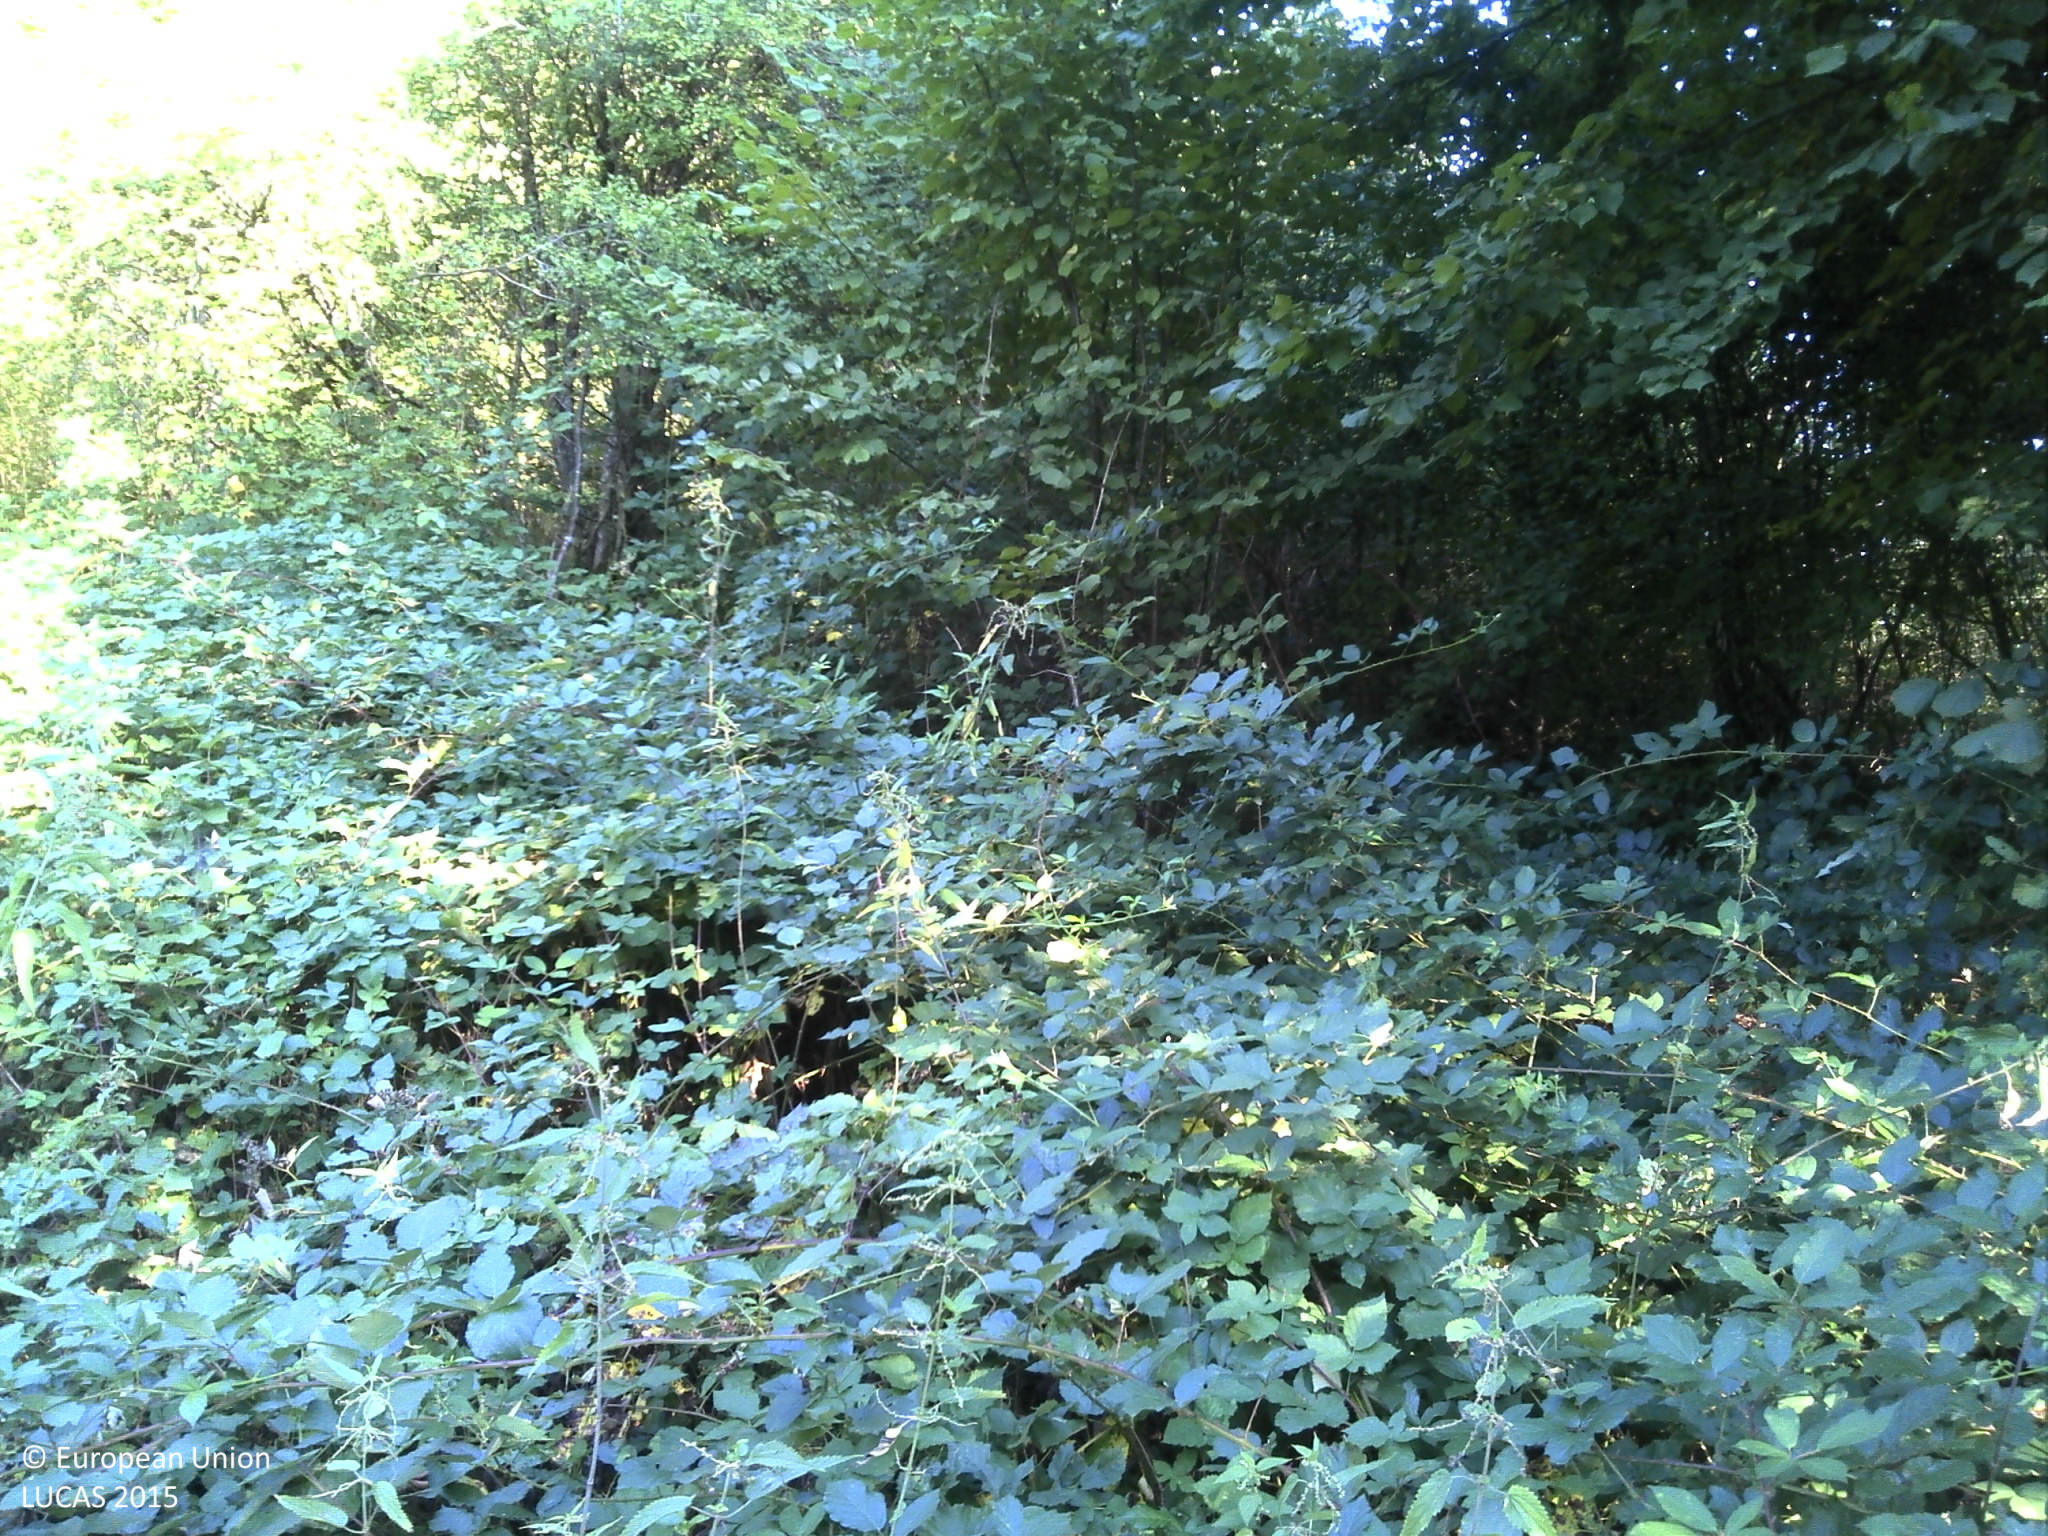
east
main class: Grassland
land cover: Spontaneously vegetated surfaces
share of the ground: > 75 %
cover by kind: herbaceous plants 100 %
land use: Forestry
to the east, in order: Spontaneously vegetated surfaces; Broadleaved woodland; Spontaneously vegetated surfaces; Tracks; Broadleaved woodland; Tracks; Broadleaved woodland
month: September
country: HR
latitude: 45.3703
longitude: 15.3200
